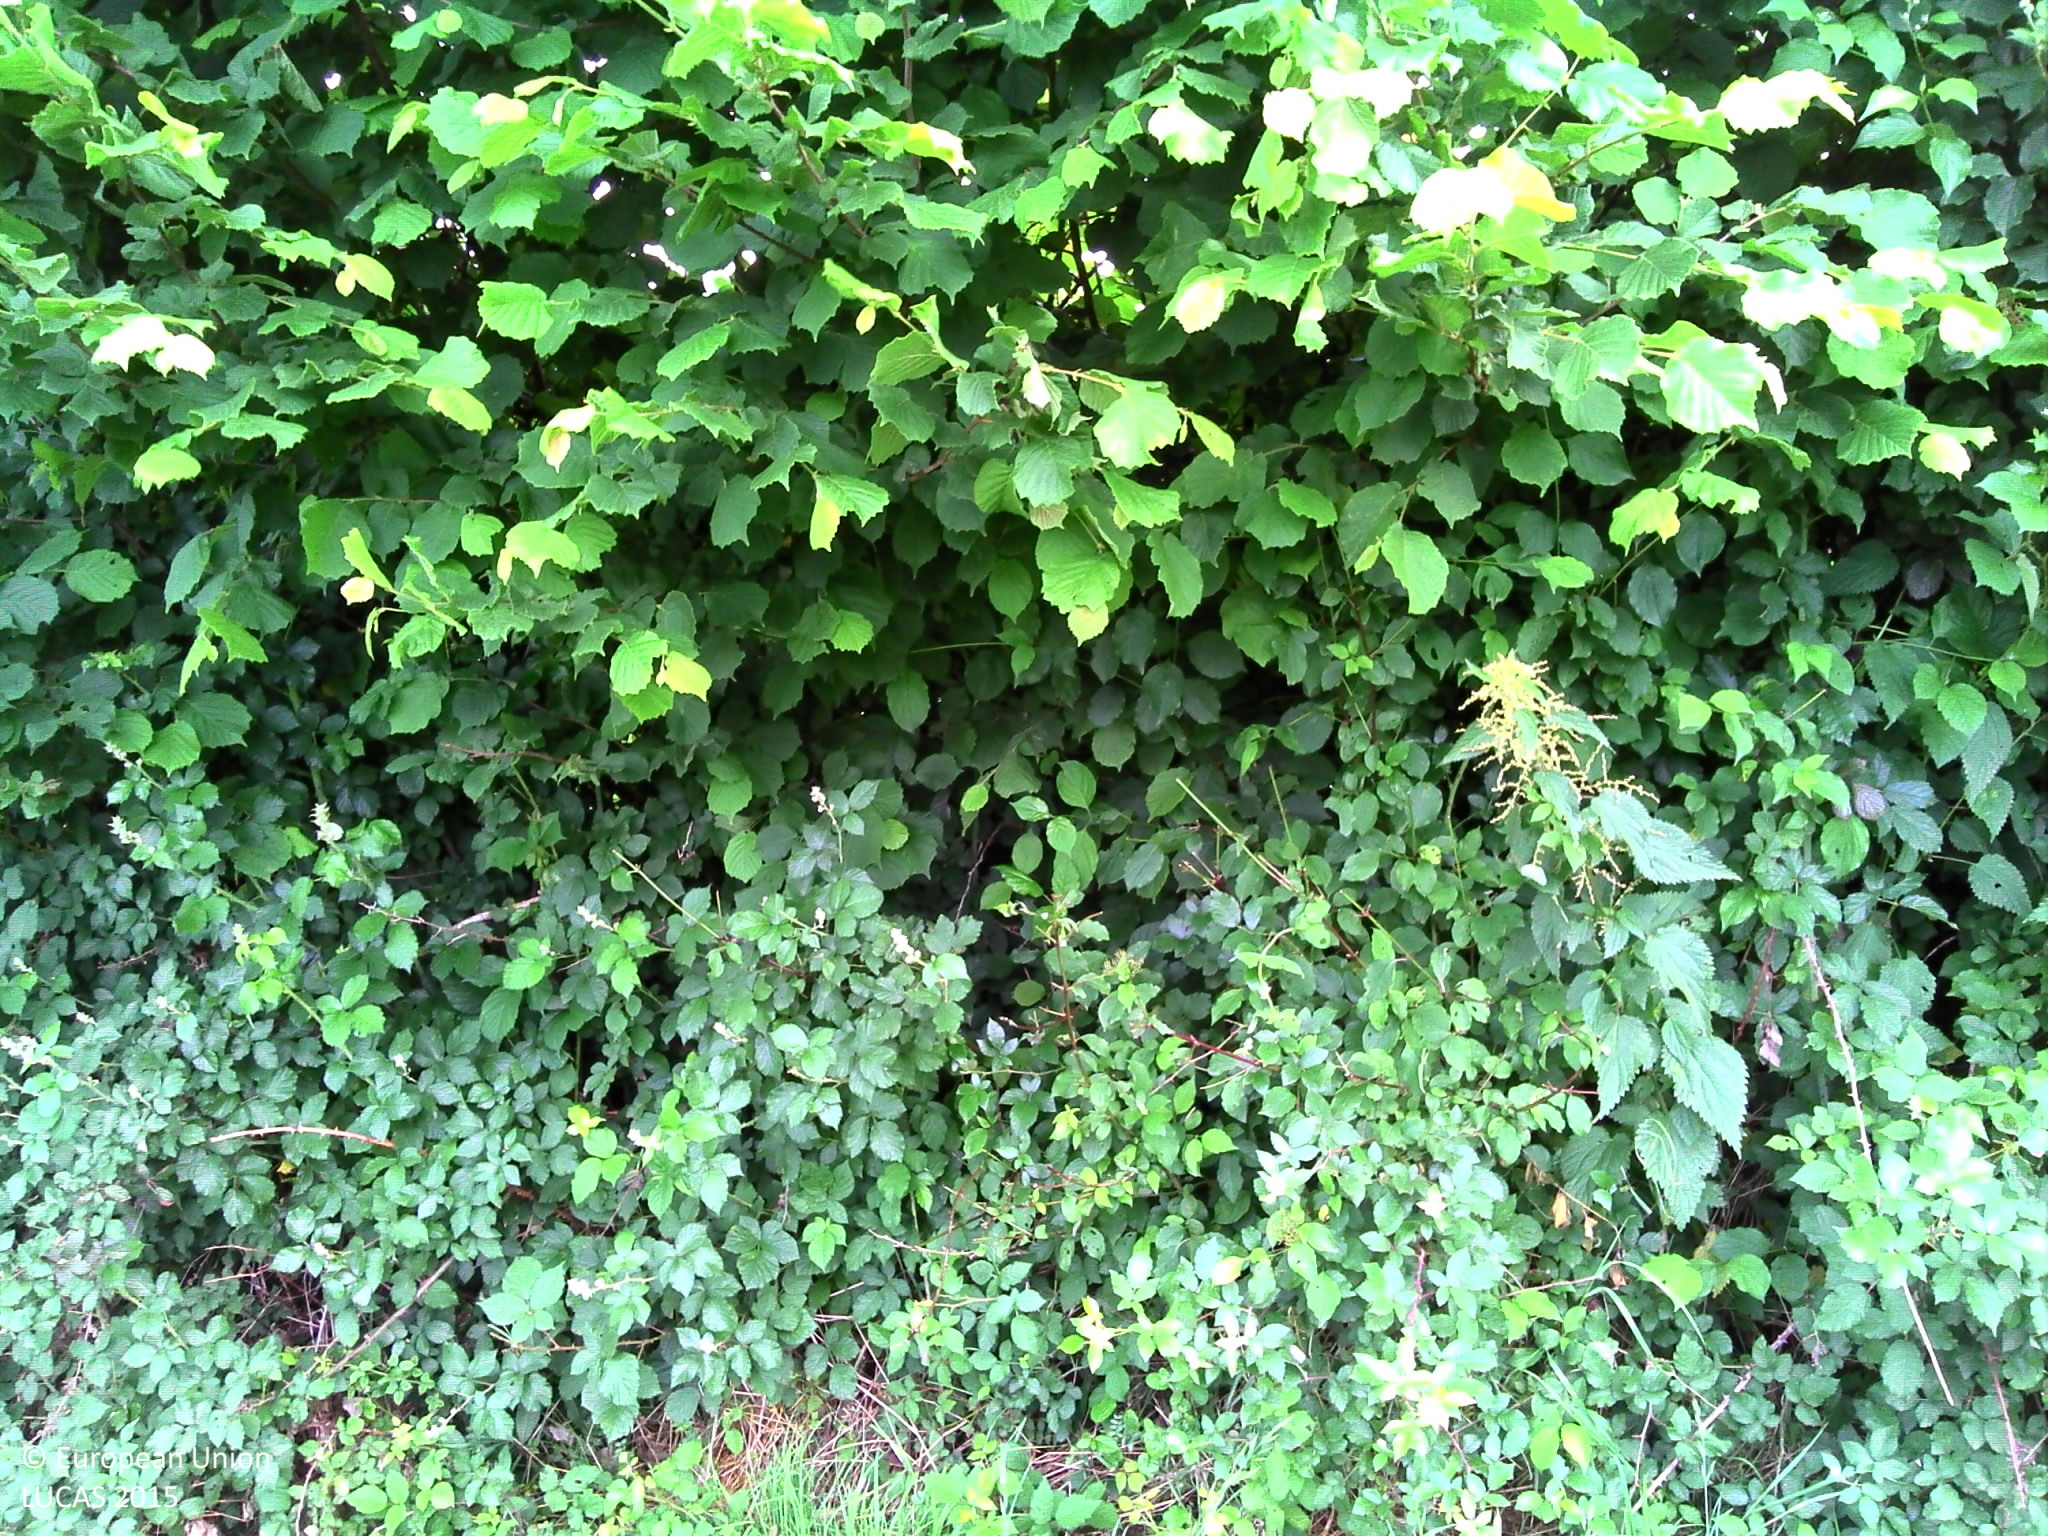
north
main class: Cropland
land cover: Barley
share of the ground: > 75 %
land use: Agriculture (excluding fallow land and kitchen gardens)
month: June
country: FR
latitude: 44.2062
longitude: 2.5077
